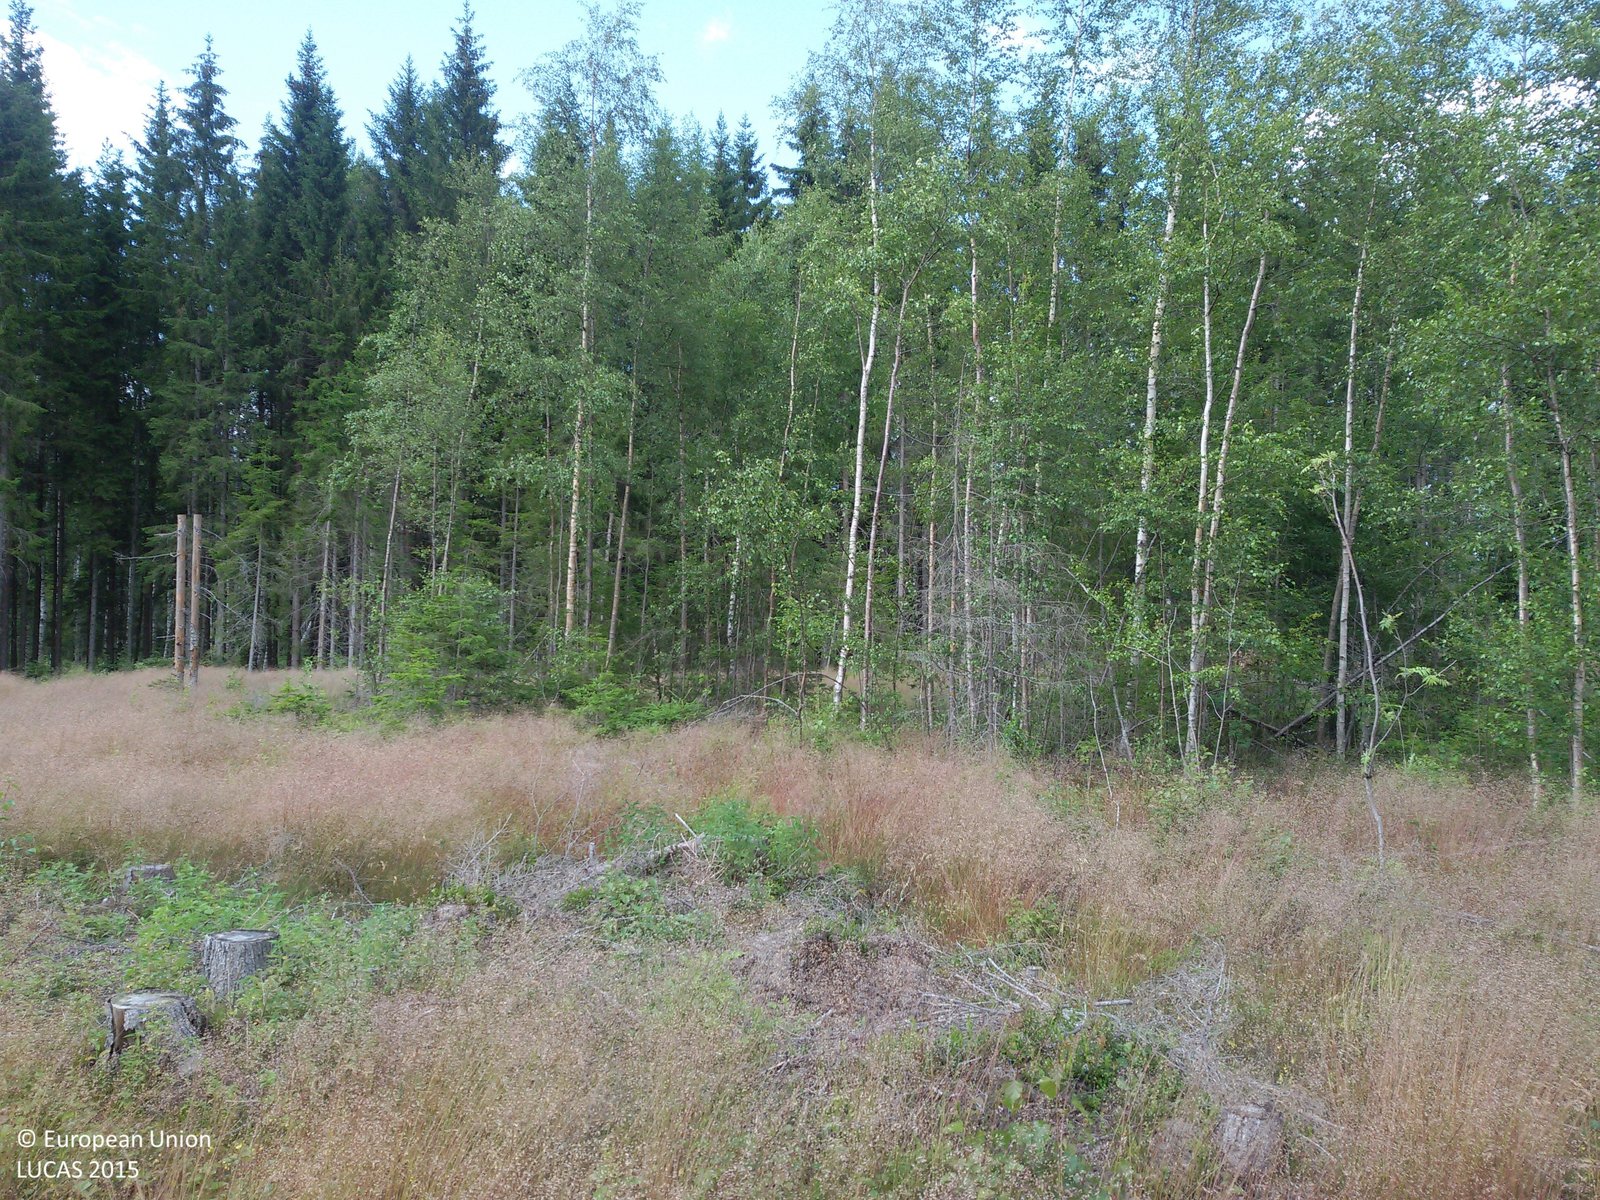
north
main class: Woodland
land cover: Spruce dominated mixed woodland
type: boreal forest
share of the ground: 25 - 50 %
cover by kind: herbaceous plants 50 %, broadleaved forest trees 30 %, coniferous forest trees 20 %
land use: Forestry
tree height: < 5 m
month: July
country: SE
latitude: 60.4389
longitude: 15.3848
